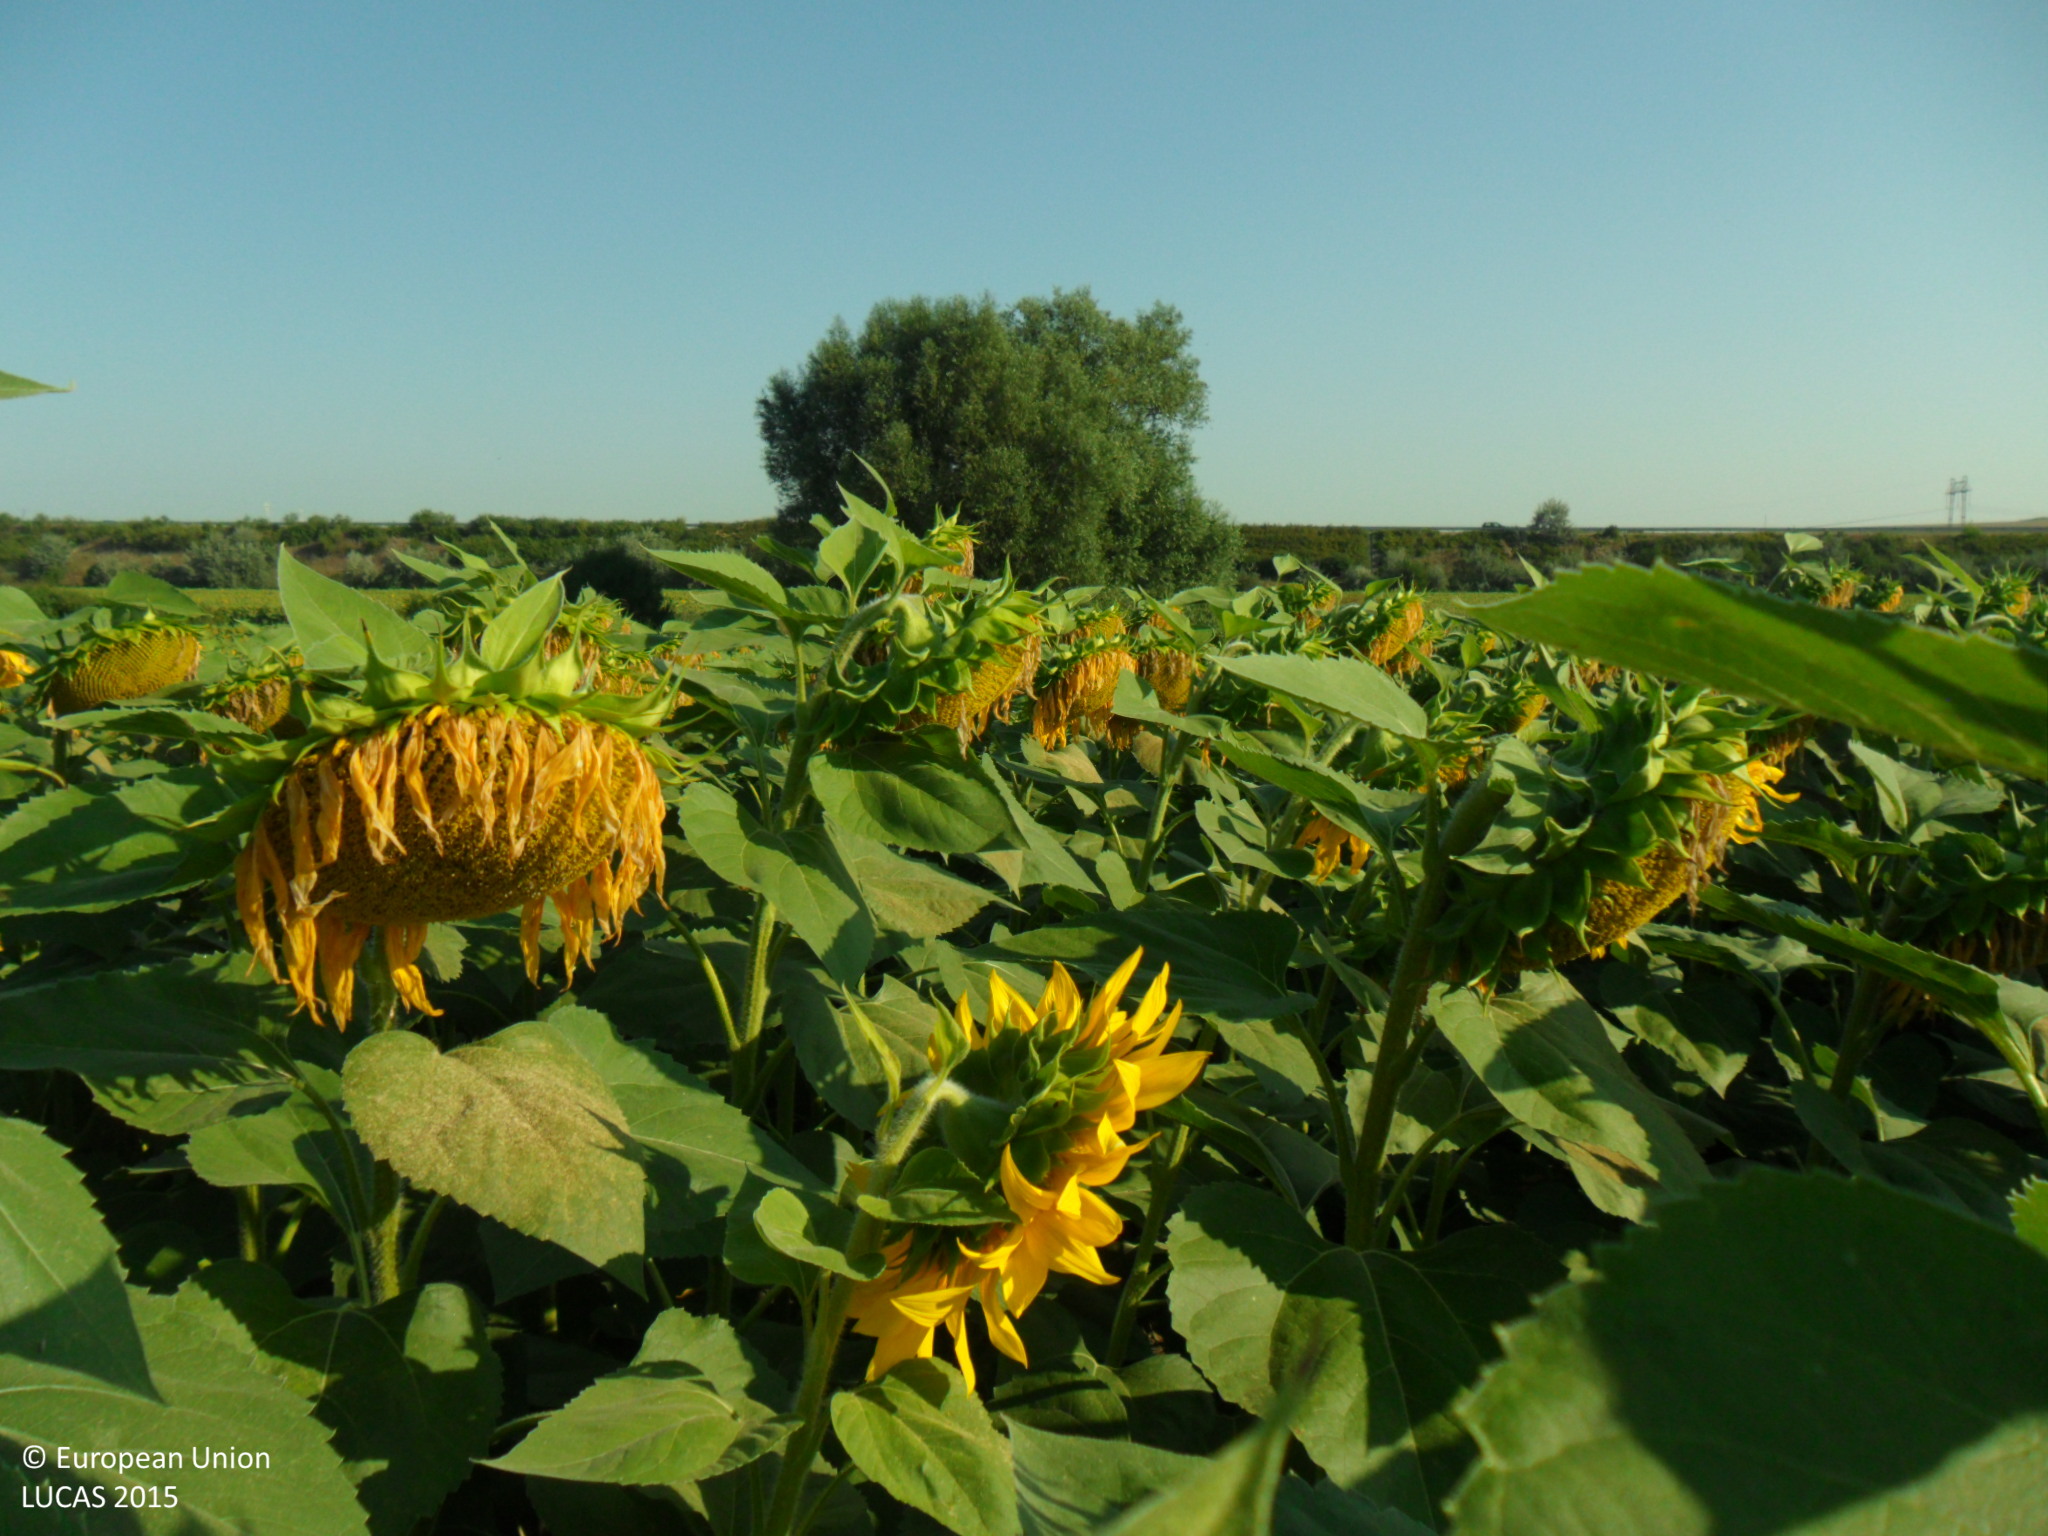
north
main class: Cropland
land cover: Sunflower
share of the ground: > 75 %
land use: Agriculture (excluding fallow land and kitchen gardens)
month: July
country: BG
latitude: 43.3194
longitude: 27.1226
